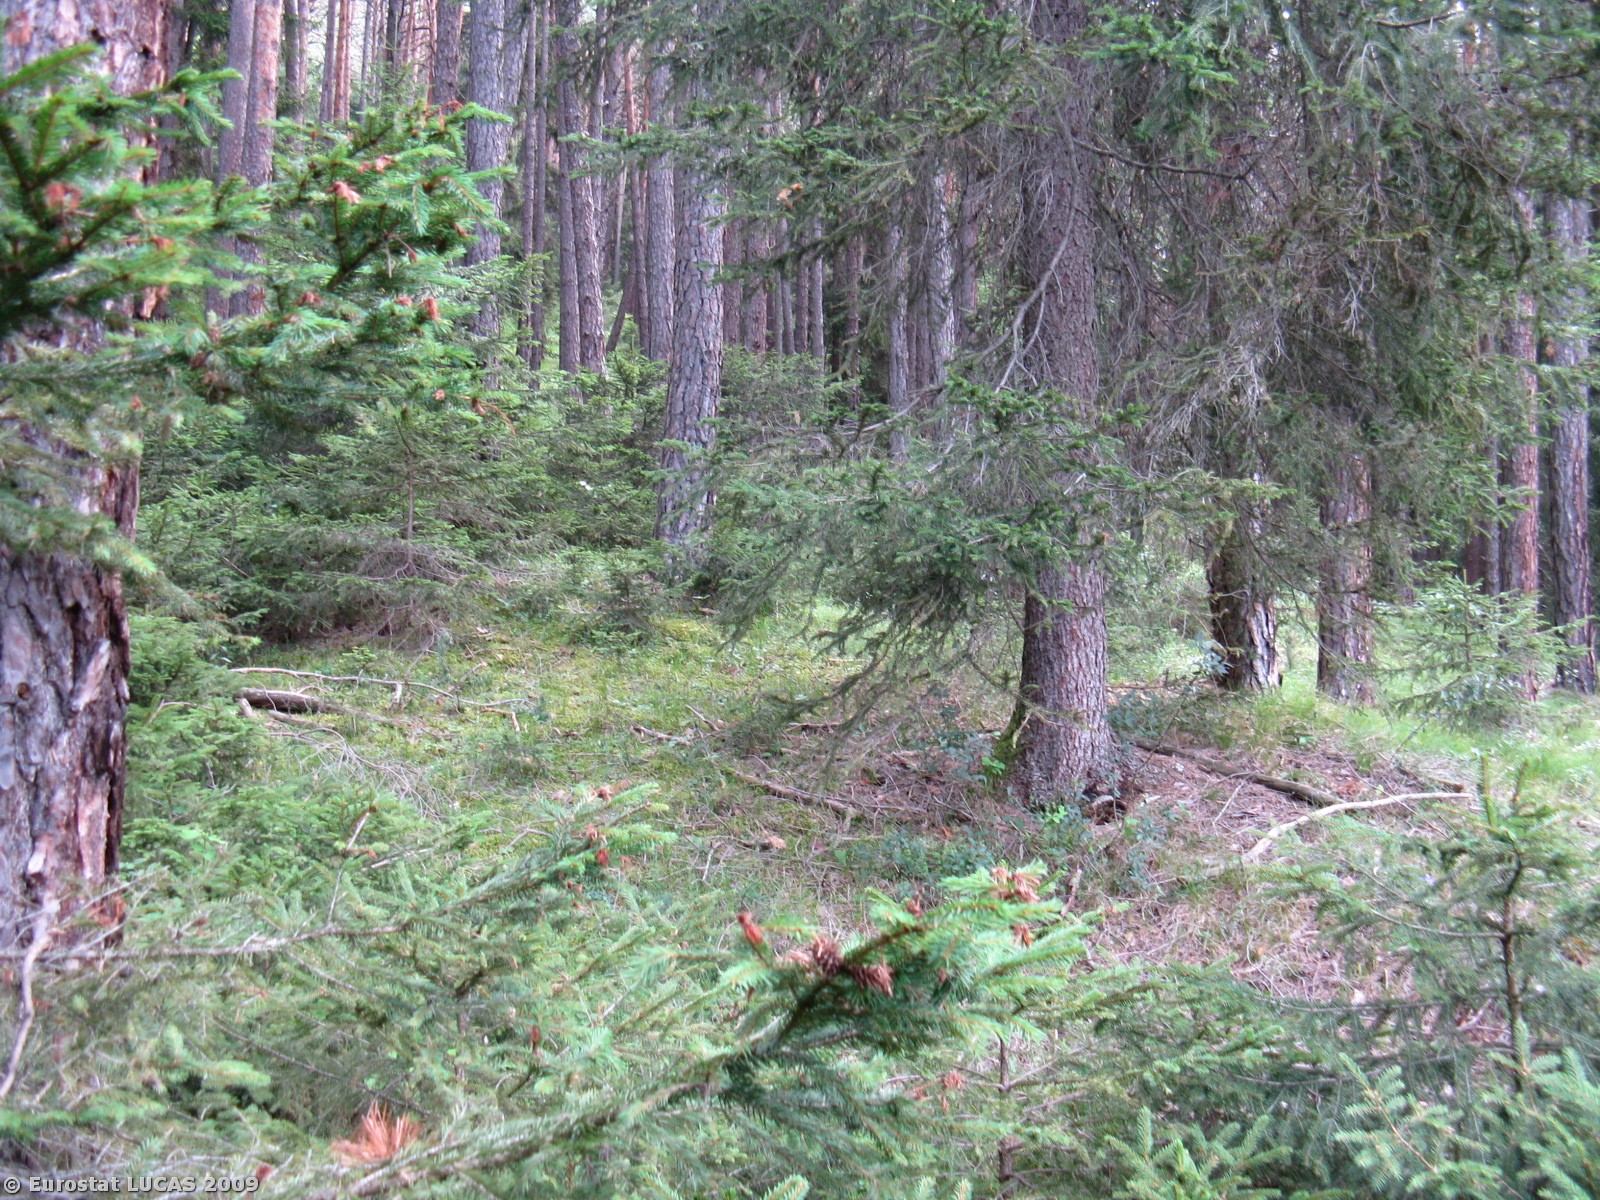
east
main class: Woodland
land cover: Coniferous woodland
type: alpine coniferous forest
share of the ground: > 75 %
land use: Forestry
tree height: > 5 m
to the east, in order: Coniferous woodland
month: July
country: AT
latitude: 47.2995
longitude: 11.1495
